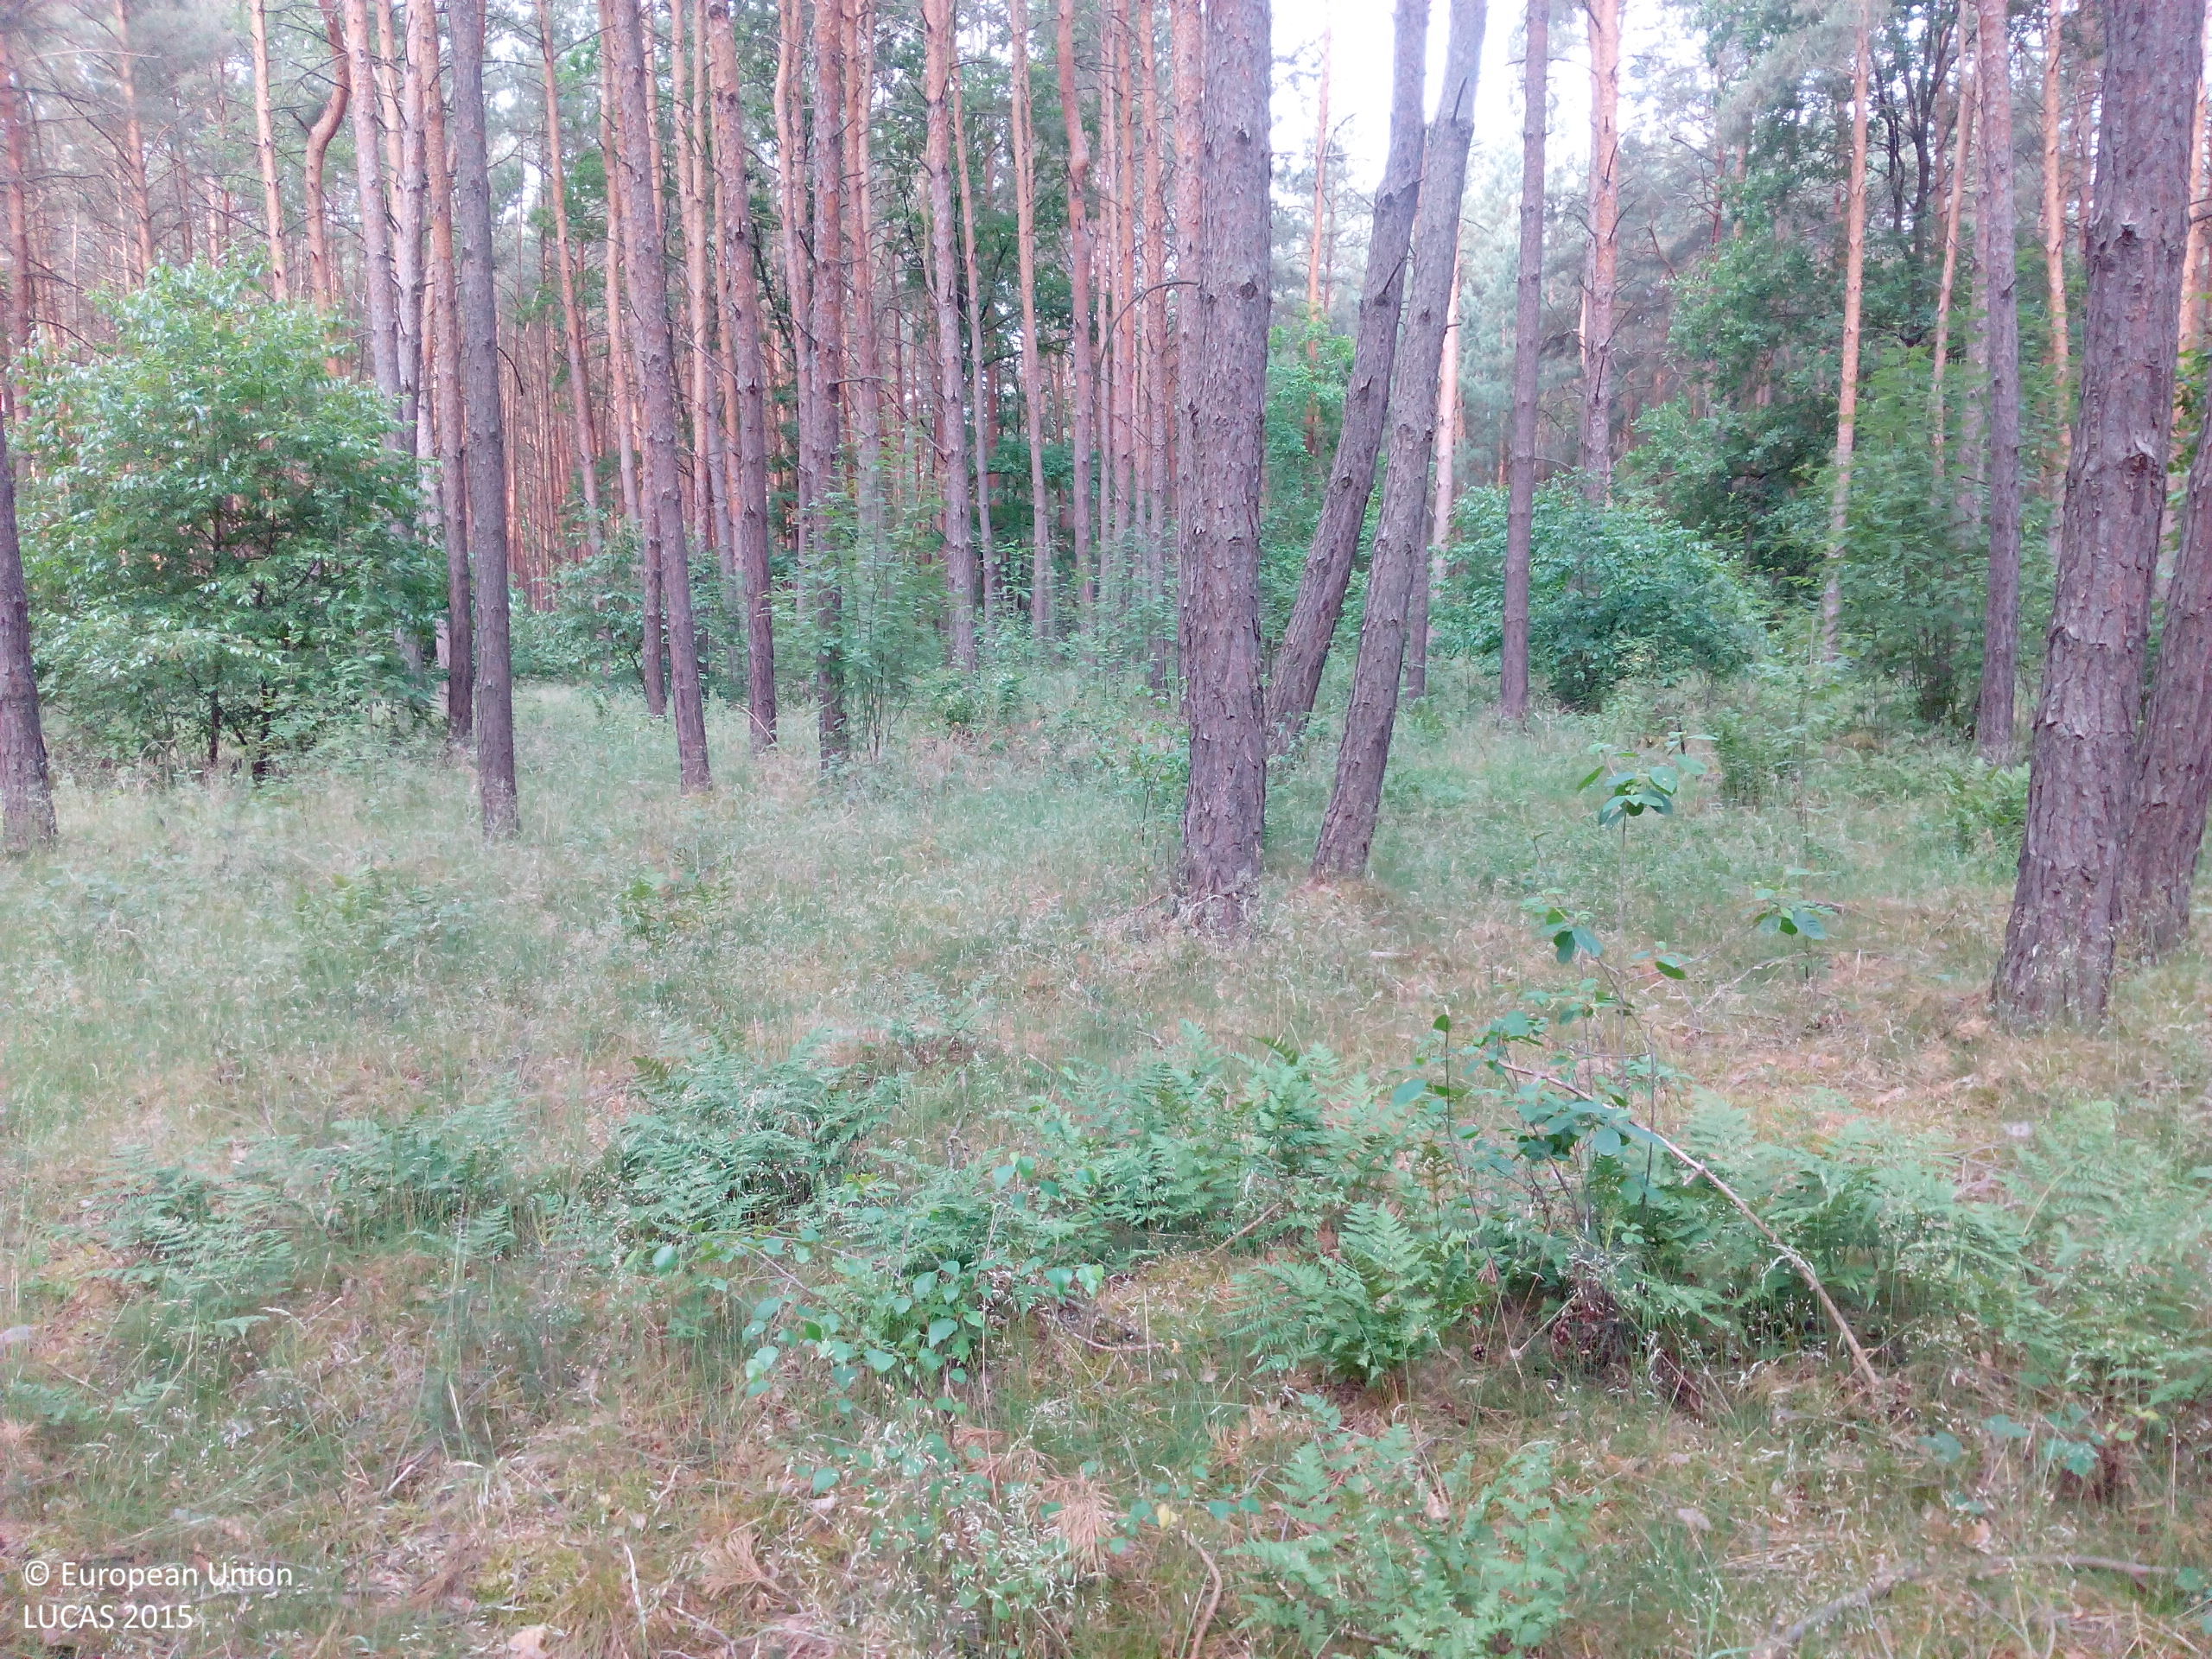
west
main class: Woodland
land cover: Pine dominated coniferous woodland
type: hemiboreal forest and nemoral coniferous forest and mixed broadleaved-coniferous forest
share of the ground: > 75 %
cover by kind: coniferous forest trees 80 %, broadleaved forest trees 15 %, shrubs 5 %
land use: Forestry
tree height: > 5 m
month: June
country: DE
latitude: 51.5408
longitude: 12.5518
